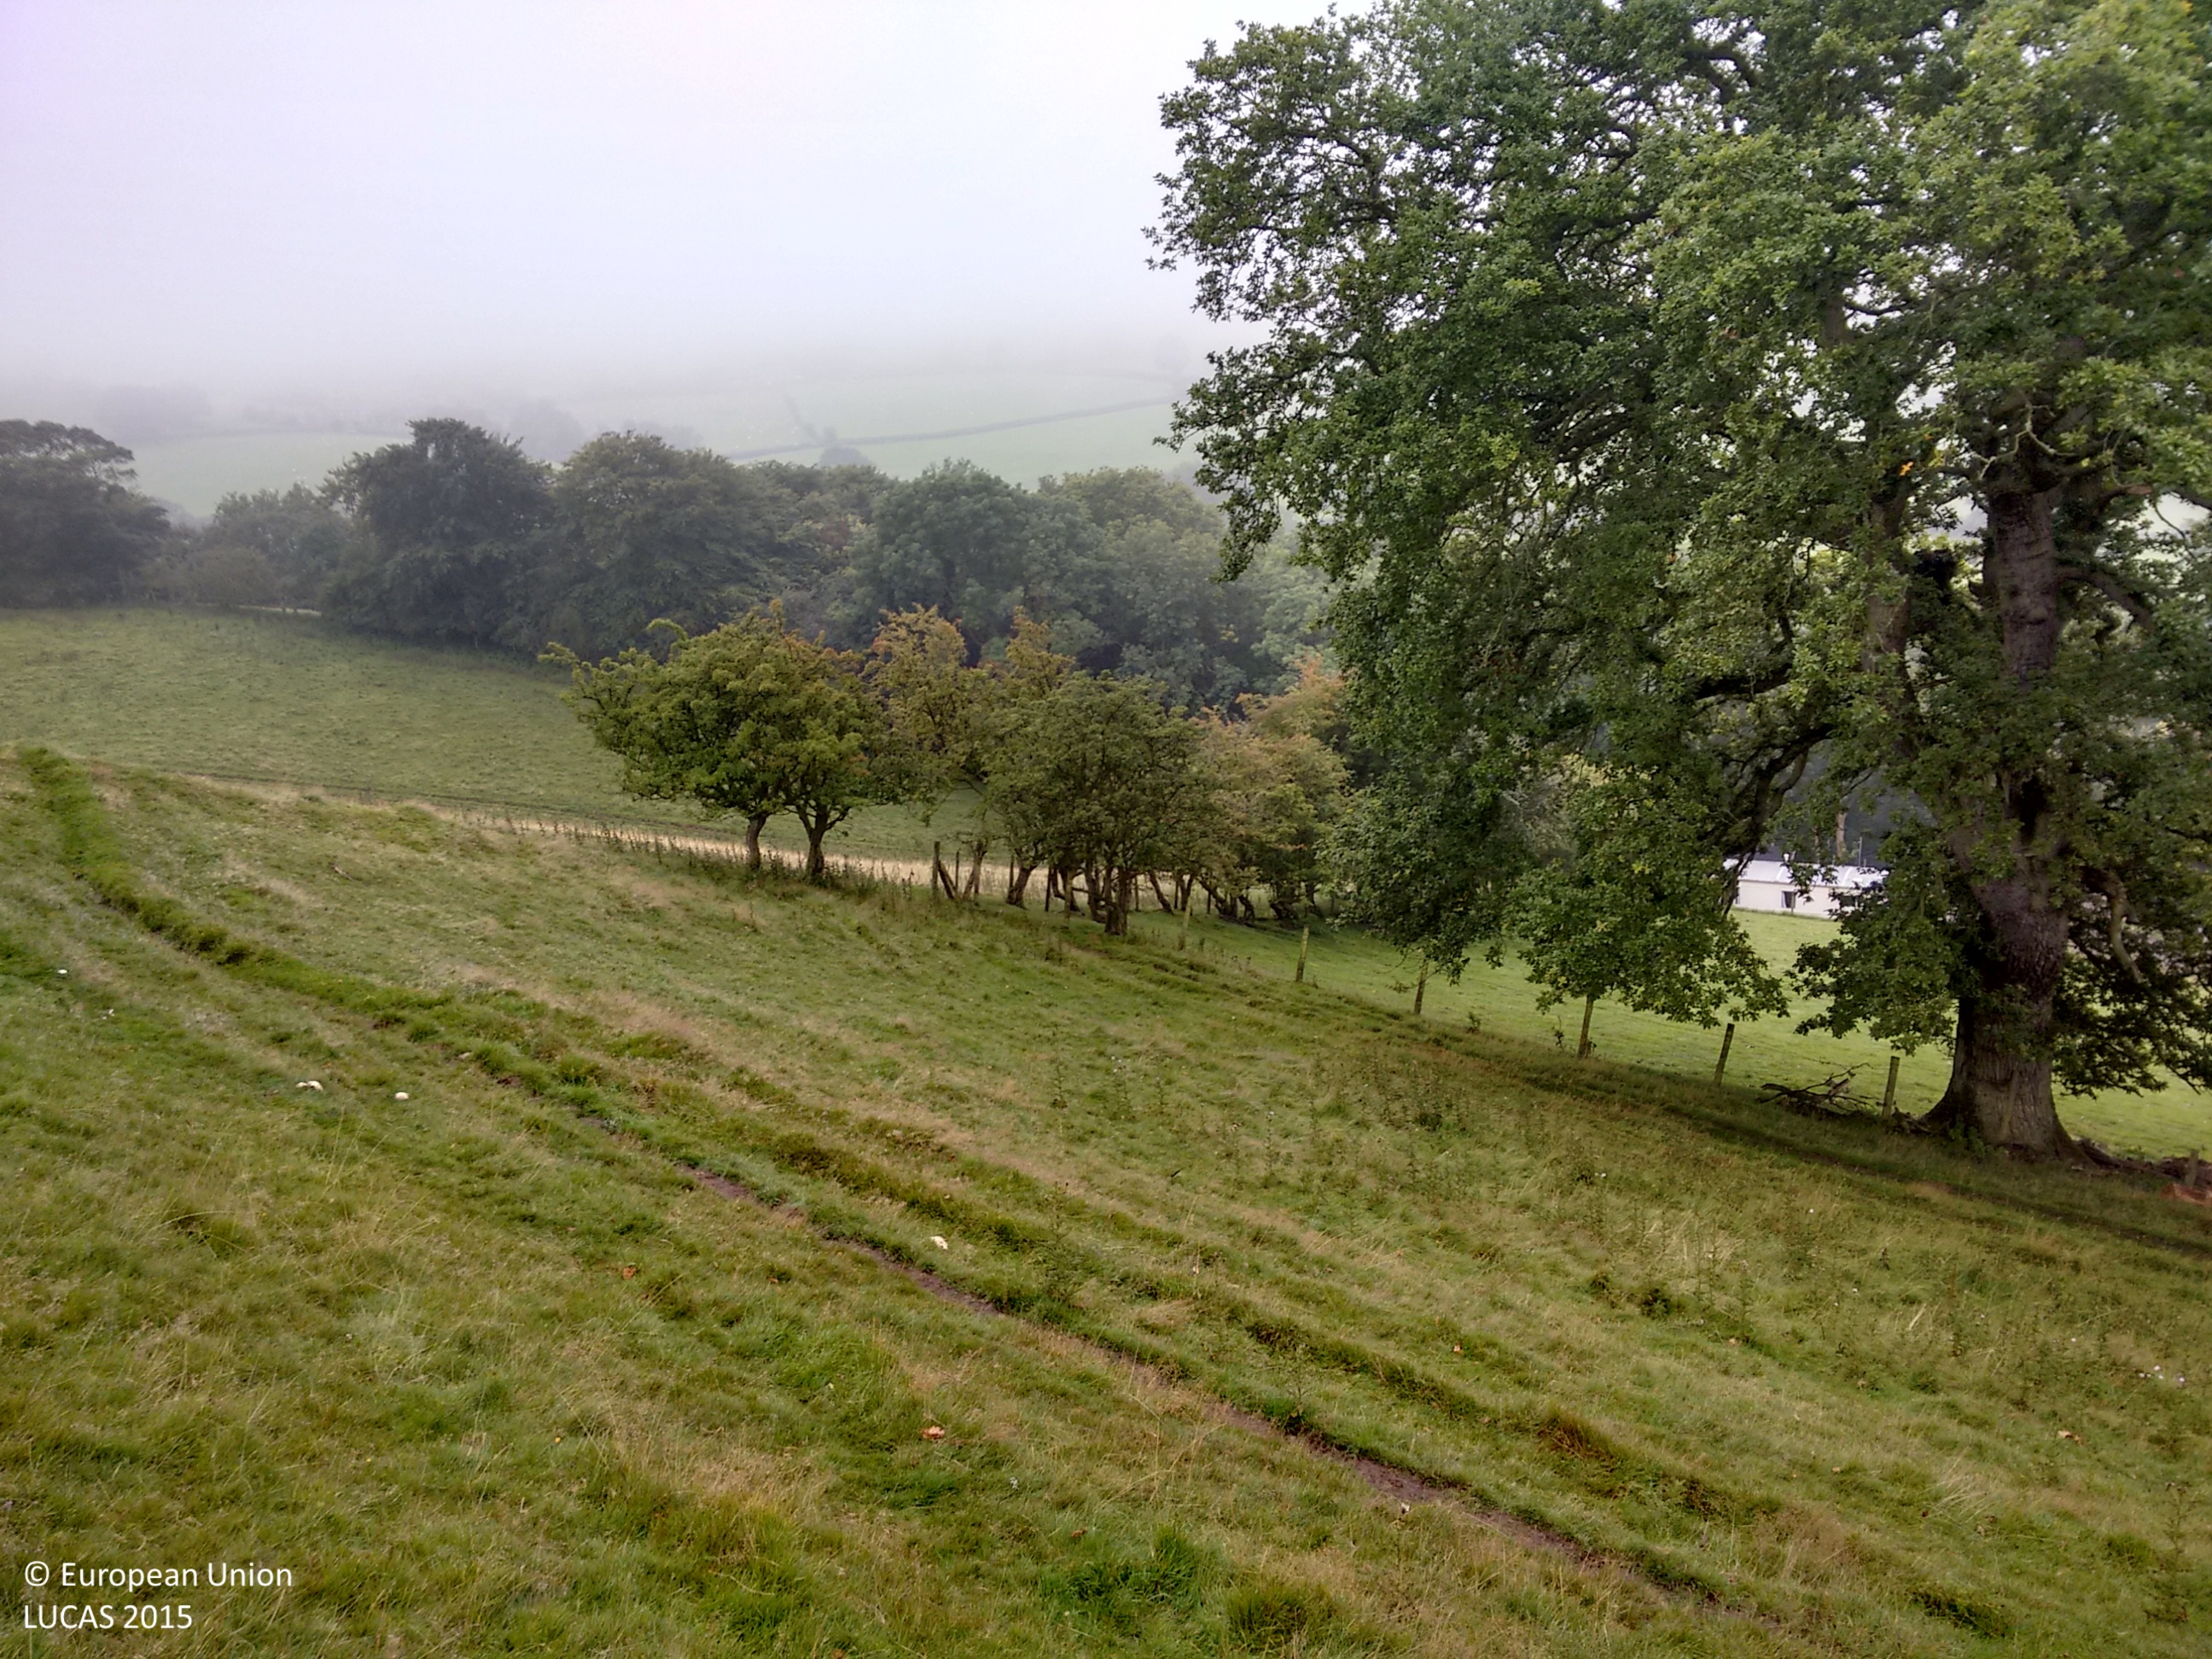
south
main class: Grassland
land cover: Grassland without tree/shrub cover
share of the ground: > 75 %
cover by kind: herbaceous plants 100 %
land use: Agriculture (excluding fallow land and kitchen gardens)
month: September
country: GB
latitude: 52.5633
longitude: -2.8925
